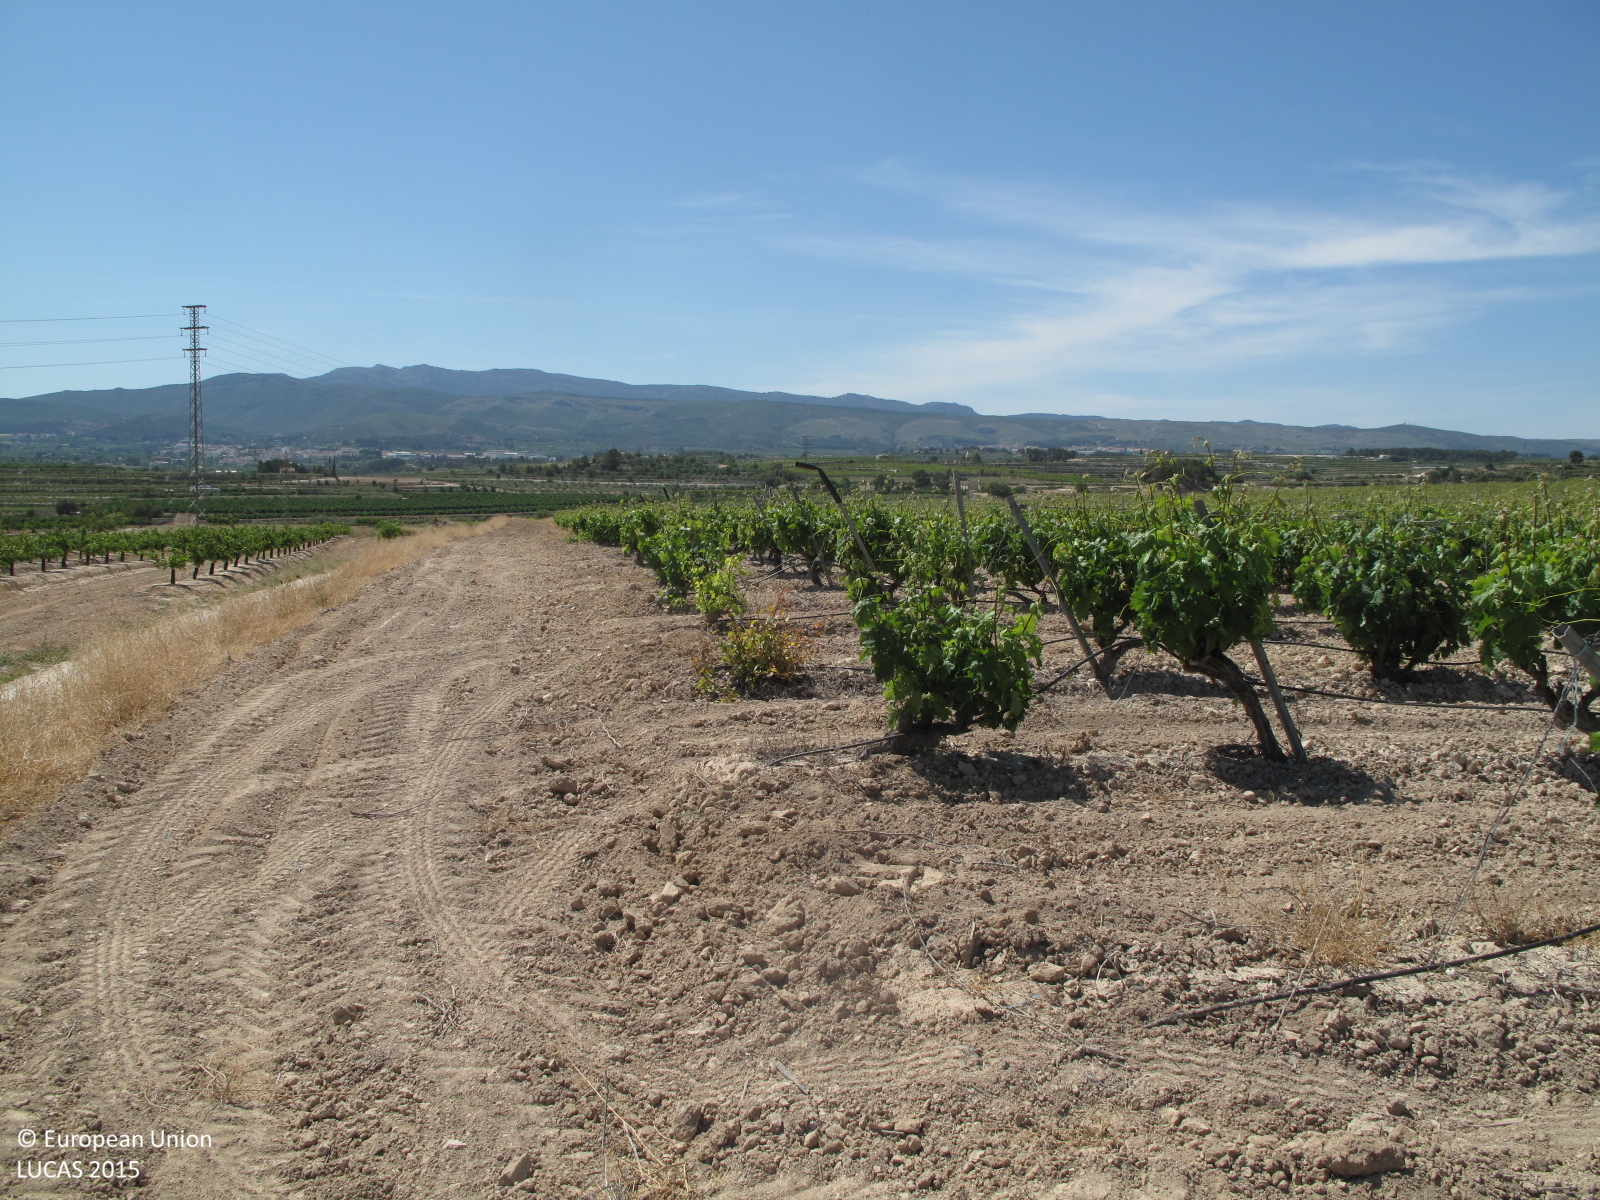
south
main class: Cropland
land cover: Vineyards
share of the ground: 25 - 50 %
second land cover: Other bare soil
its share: > 75 %
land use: Agriculture (excluding fallow land and kitchen gardens)
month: May
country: ES
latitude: 38.8772
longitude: -0.5386
